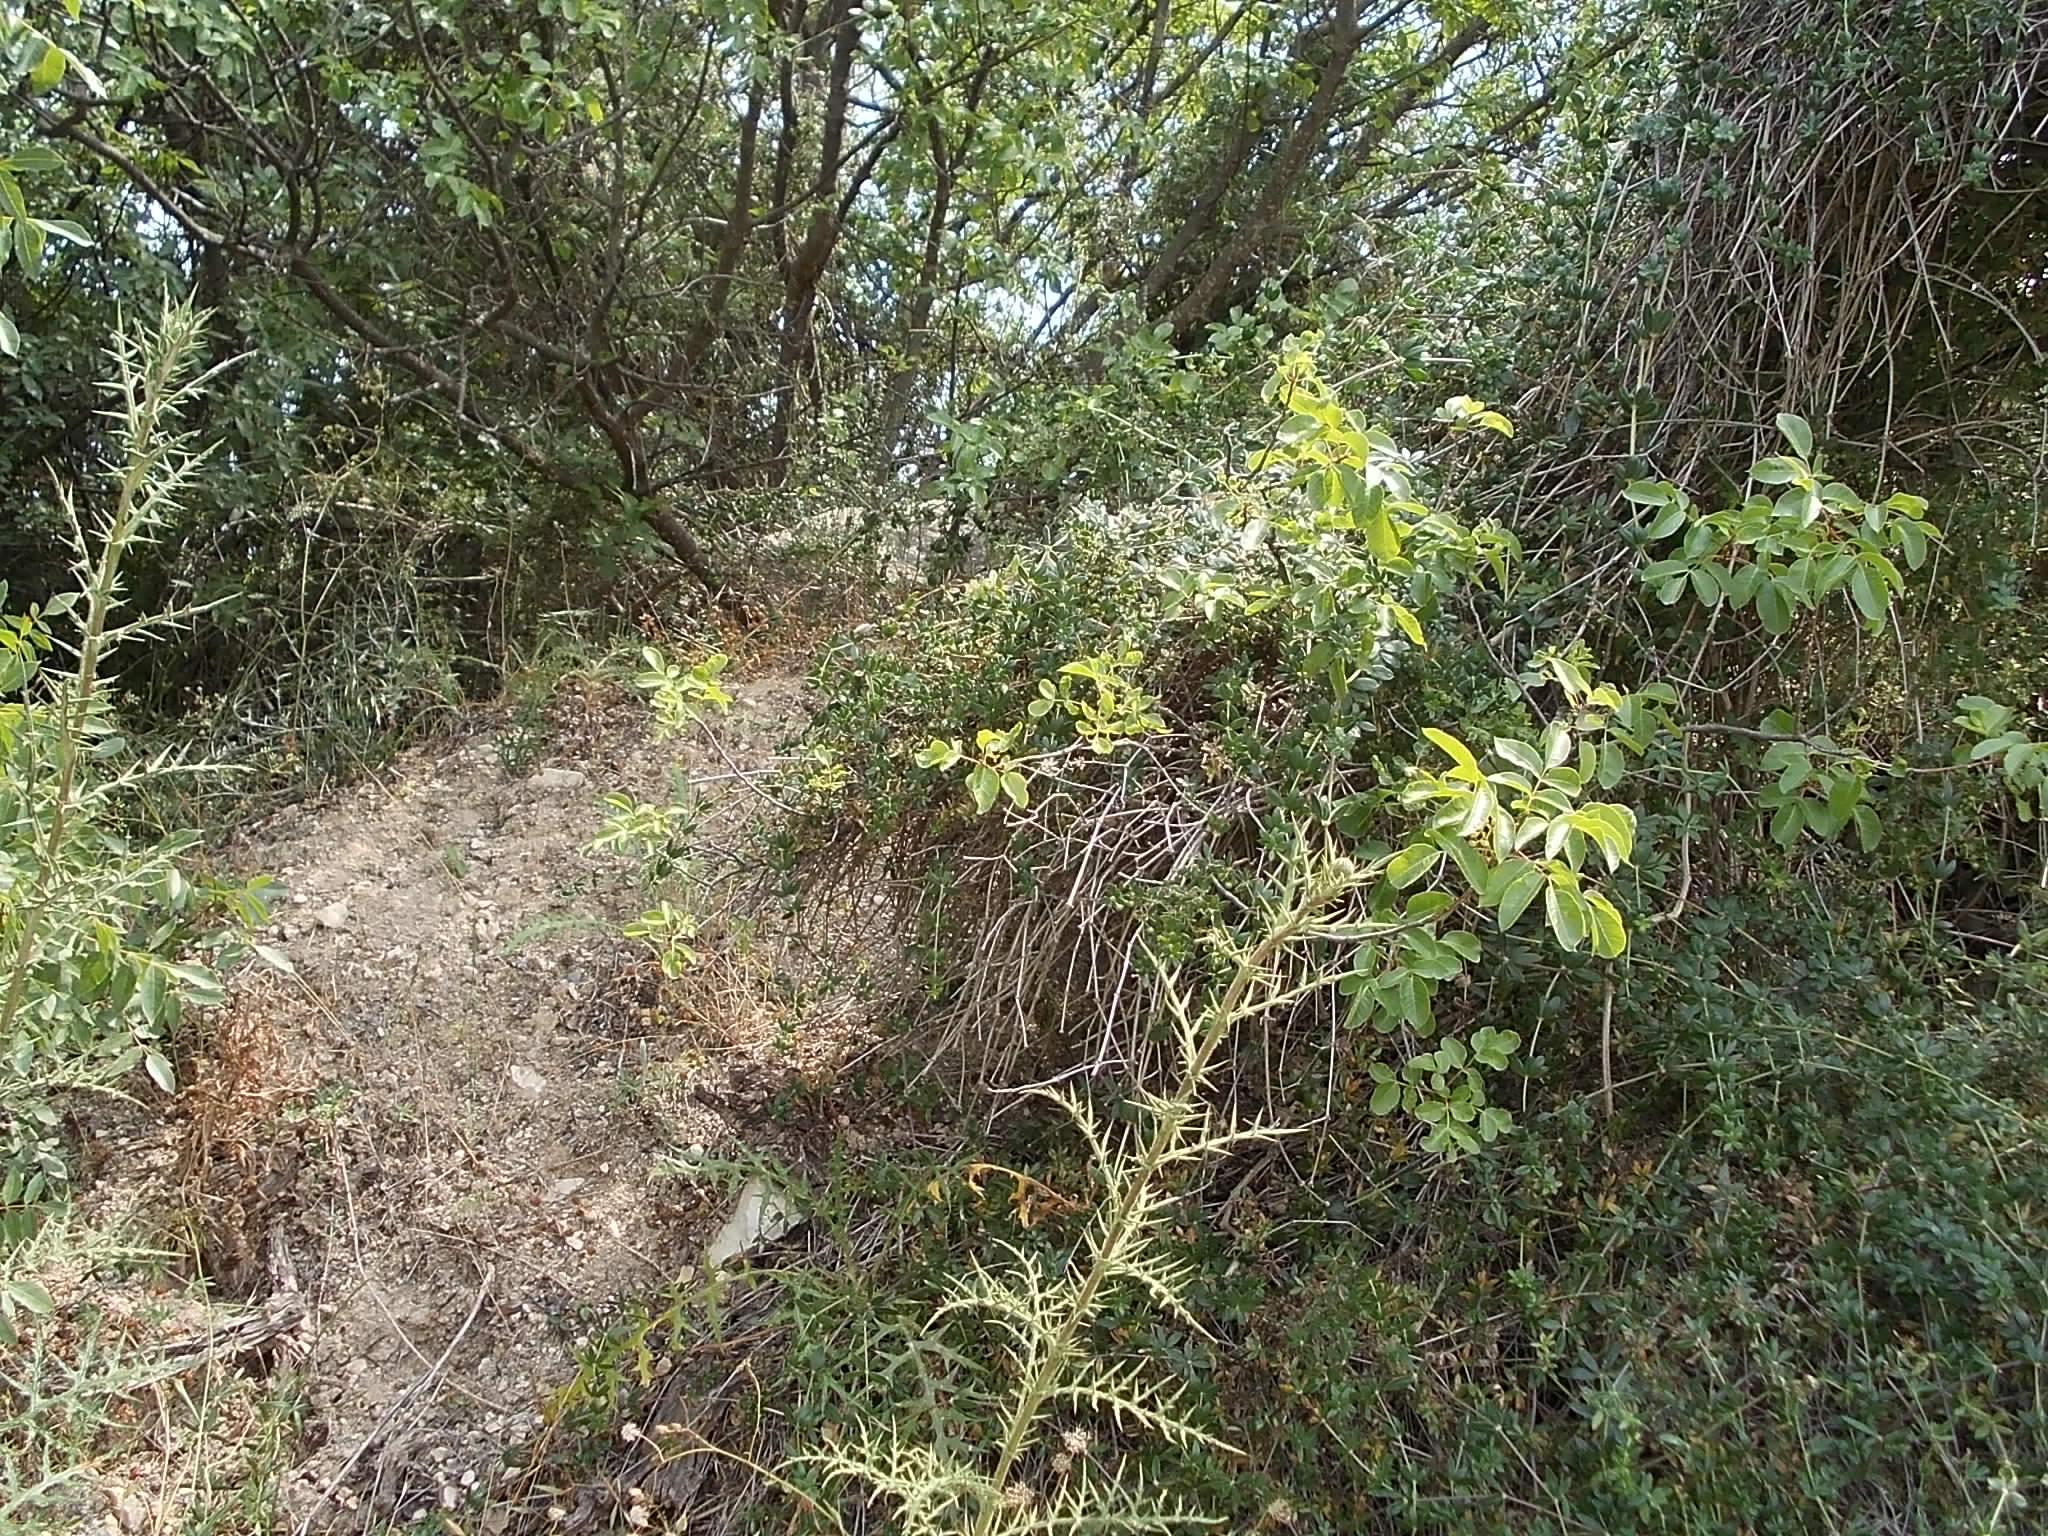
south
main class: Grassland
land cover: Grassland with sparse tree/shrub cover
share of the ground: > 75 %
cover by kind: herbaceous plants 95 %, broadleaved forest trees 5 %
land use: Semi-natural and natural areas not in use
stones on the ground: 10 - 25 %
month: June
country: CY
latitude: 34.8278
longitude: 32.9411
